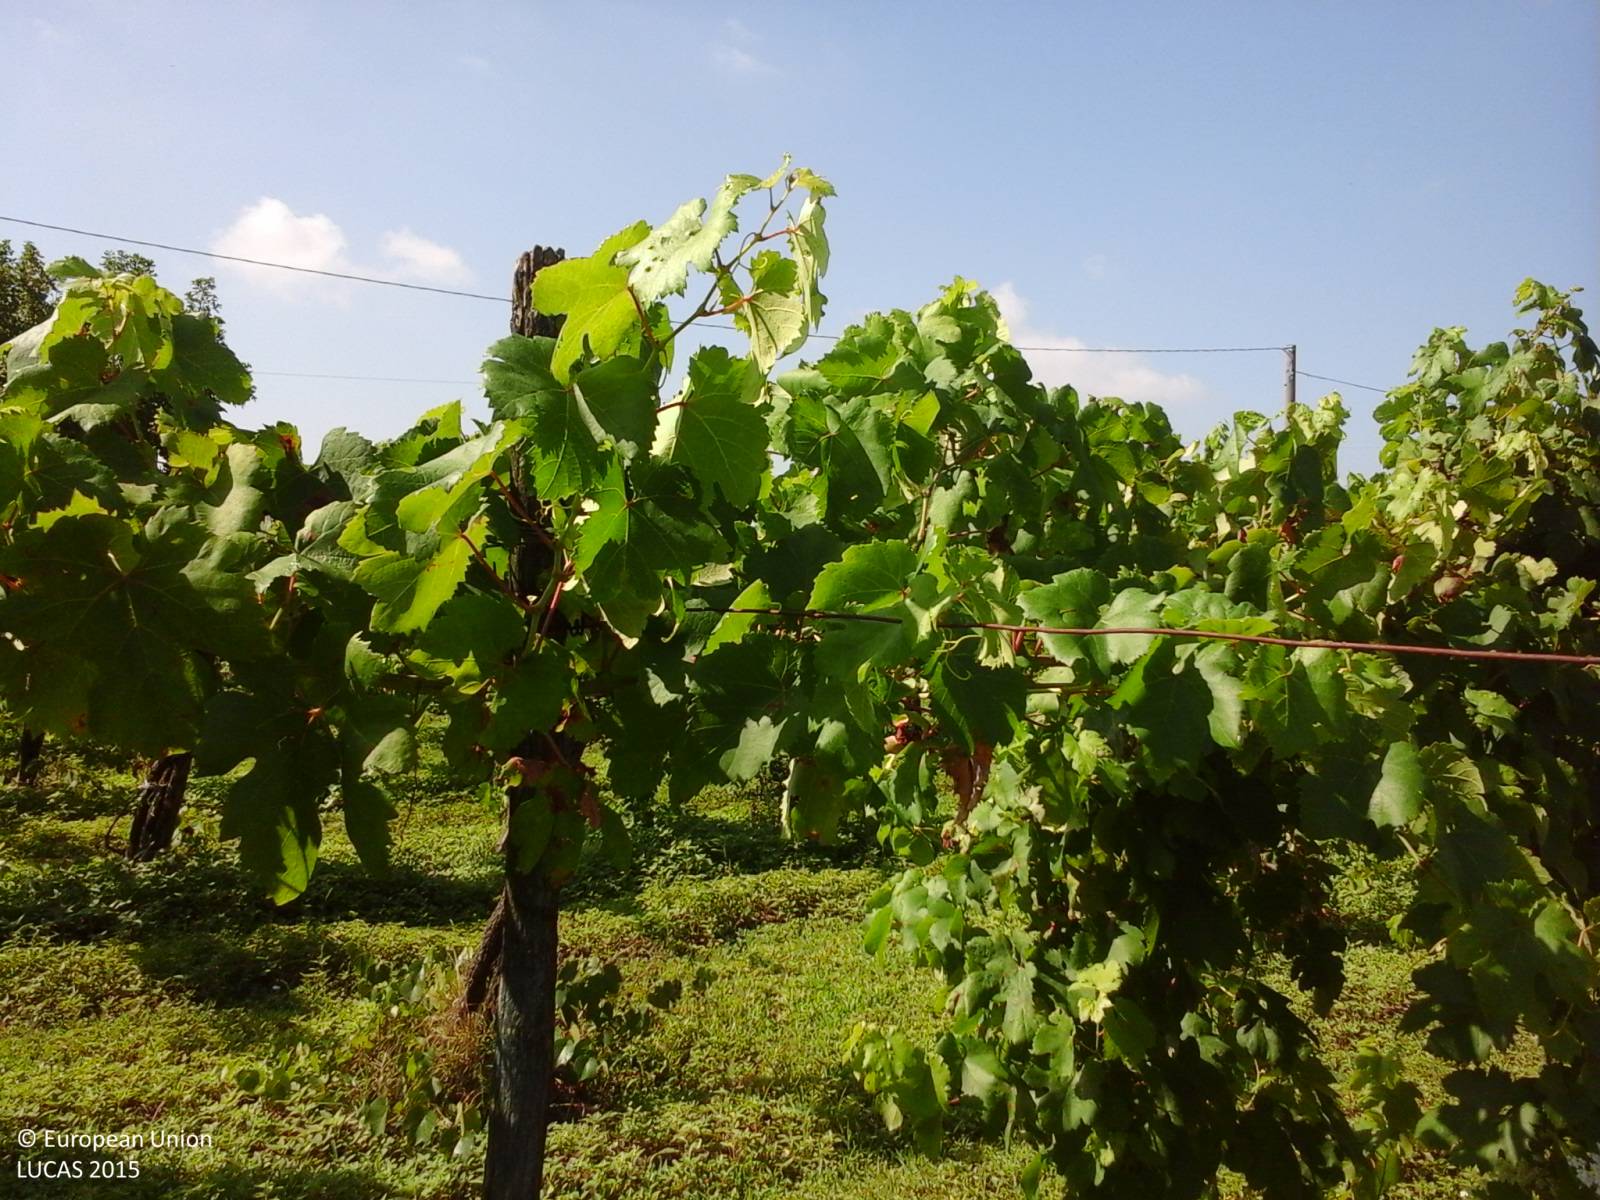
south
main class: Cropland
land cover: Vineyards
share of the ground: > 75 %
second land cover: Spontaneously vegetated surfaces
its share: > 75 %
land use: Agriculture (excluding fallow land and kitchen gardens)
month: July
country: IT
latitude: 41.2169
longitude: 14.4558
